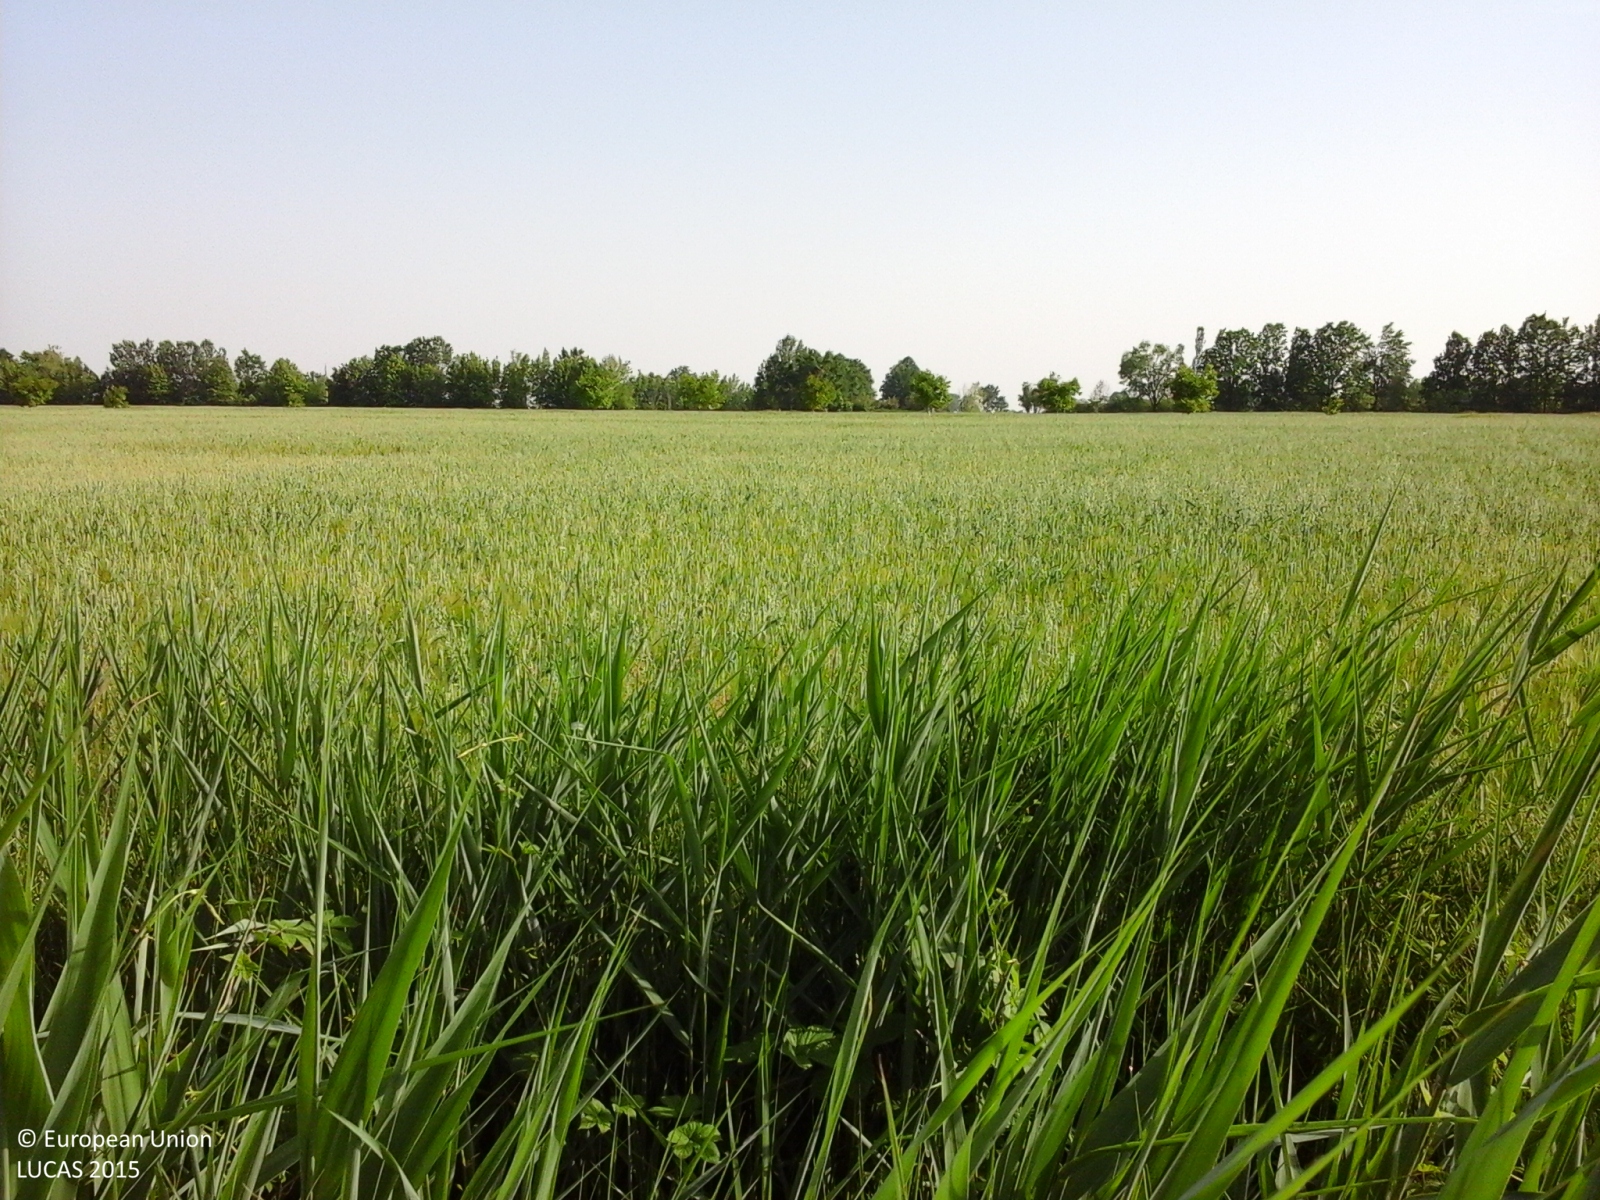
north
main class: Cropland
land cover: Common wheat
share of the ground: > 75 %
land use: Agriculture (excluding fallow land and kitchen gardens)
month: May
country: IT
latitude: 45.1797
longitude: 10.2159
